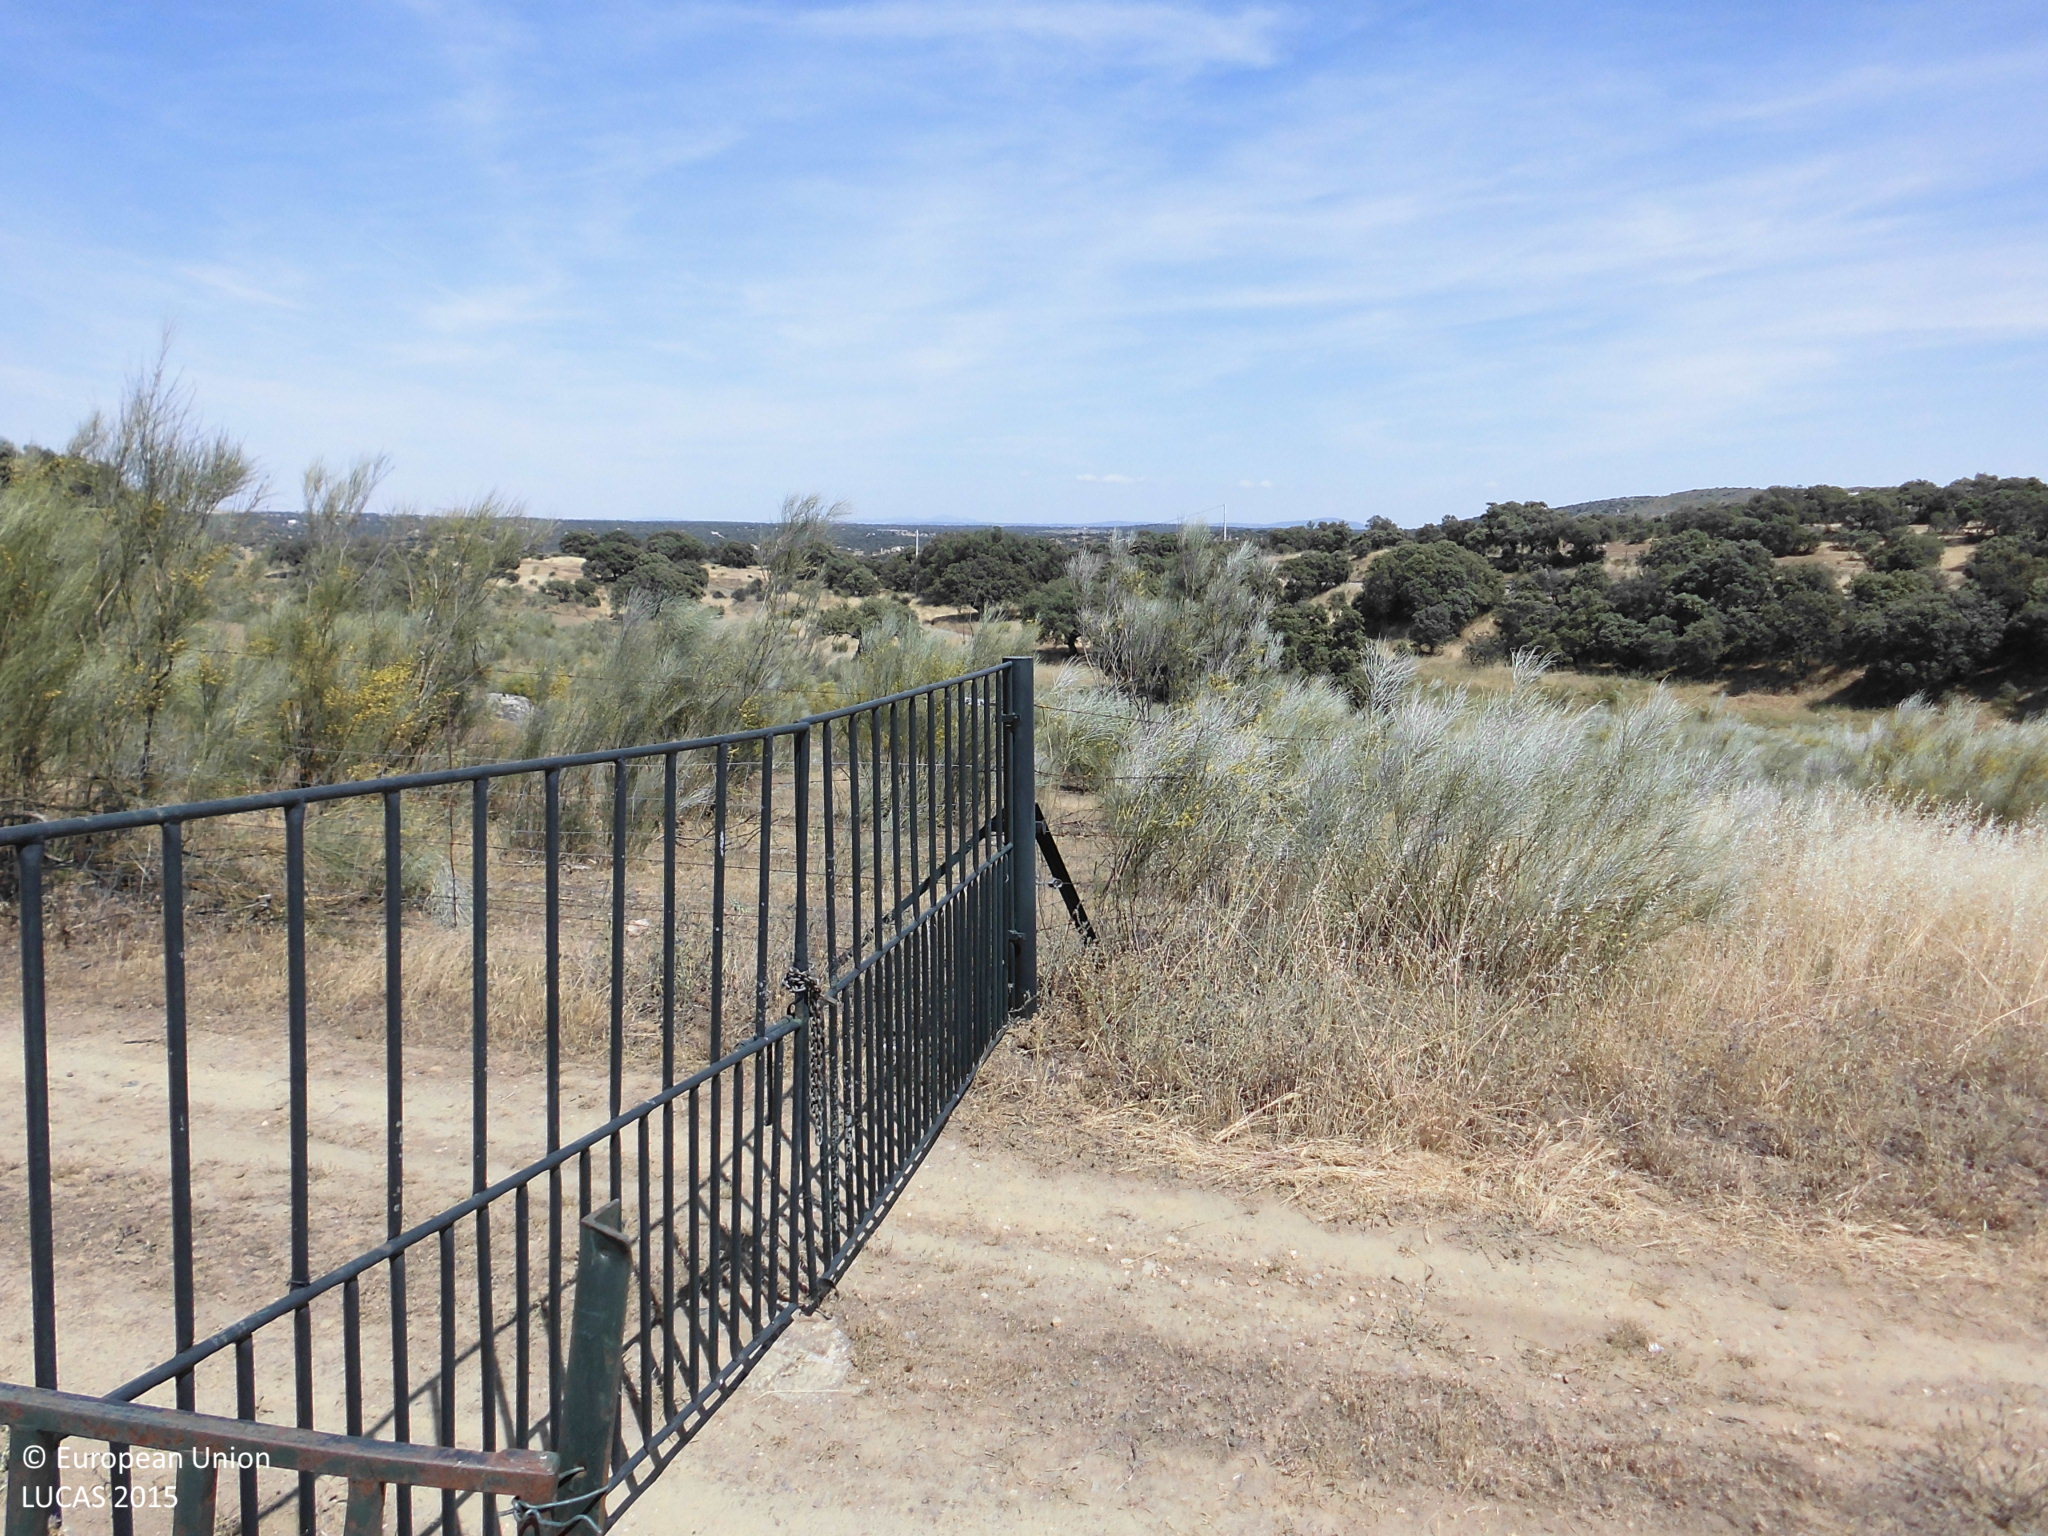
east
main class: Shrubland
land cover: Shrubland without tree cover
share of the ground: 10 - 25 %
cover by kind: herbaceous plants 85 %, shrubs 15 %
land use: Agriculture (excluding fallow land and kitchen gardens)
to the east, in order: Shrubland without tree cover; Broadleaved woodland; Tracks; Broadleaved woodland; Tracks; Shrubland with sparse tree cover; Tracks
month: May
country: ES
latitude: 39.4456
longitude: -6.0856
